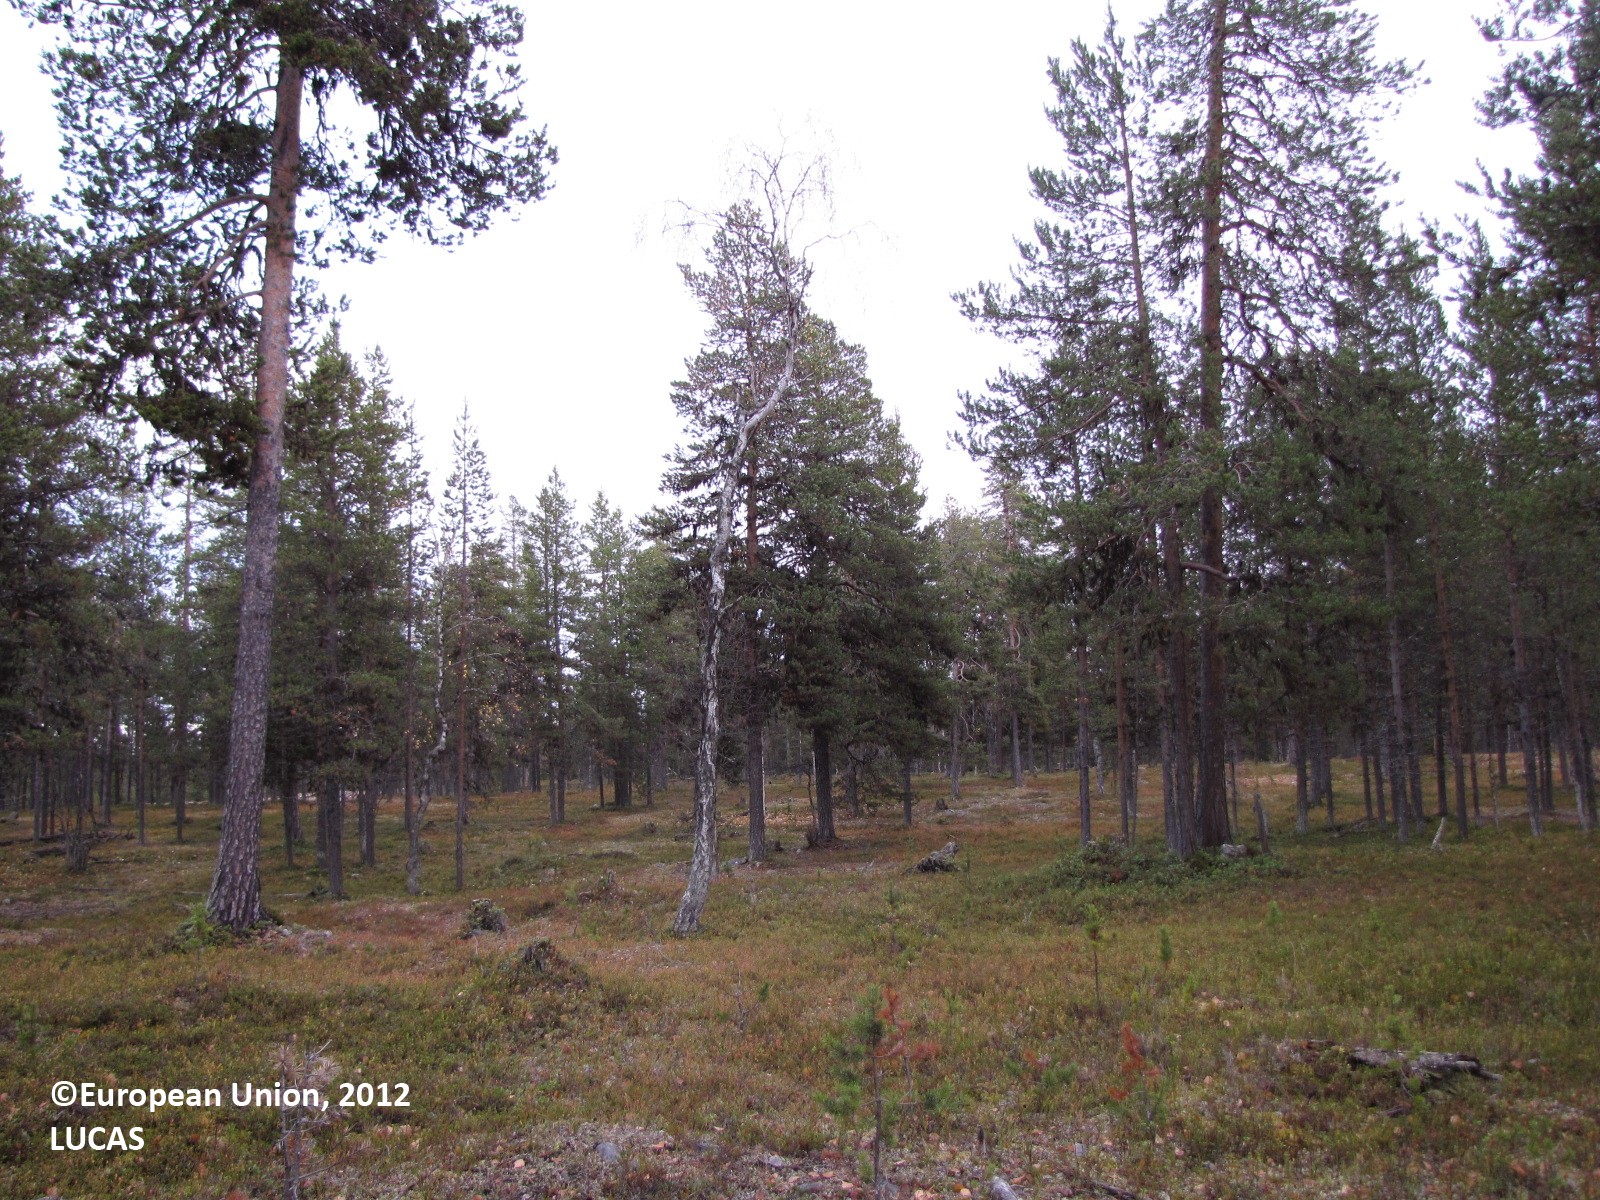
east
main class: Woodland
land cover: Pine dominated mixed woodland
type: boreal forest
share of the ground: 25 - 50 %
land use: Forestry
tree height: > 5 m
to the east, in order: Pine dominated mixed woodland
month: September
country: FI
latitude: 67.9250
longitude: 24.4490
